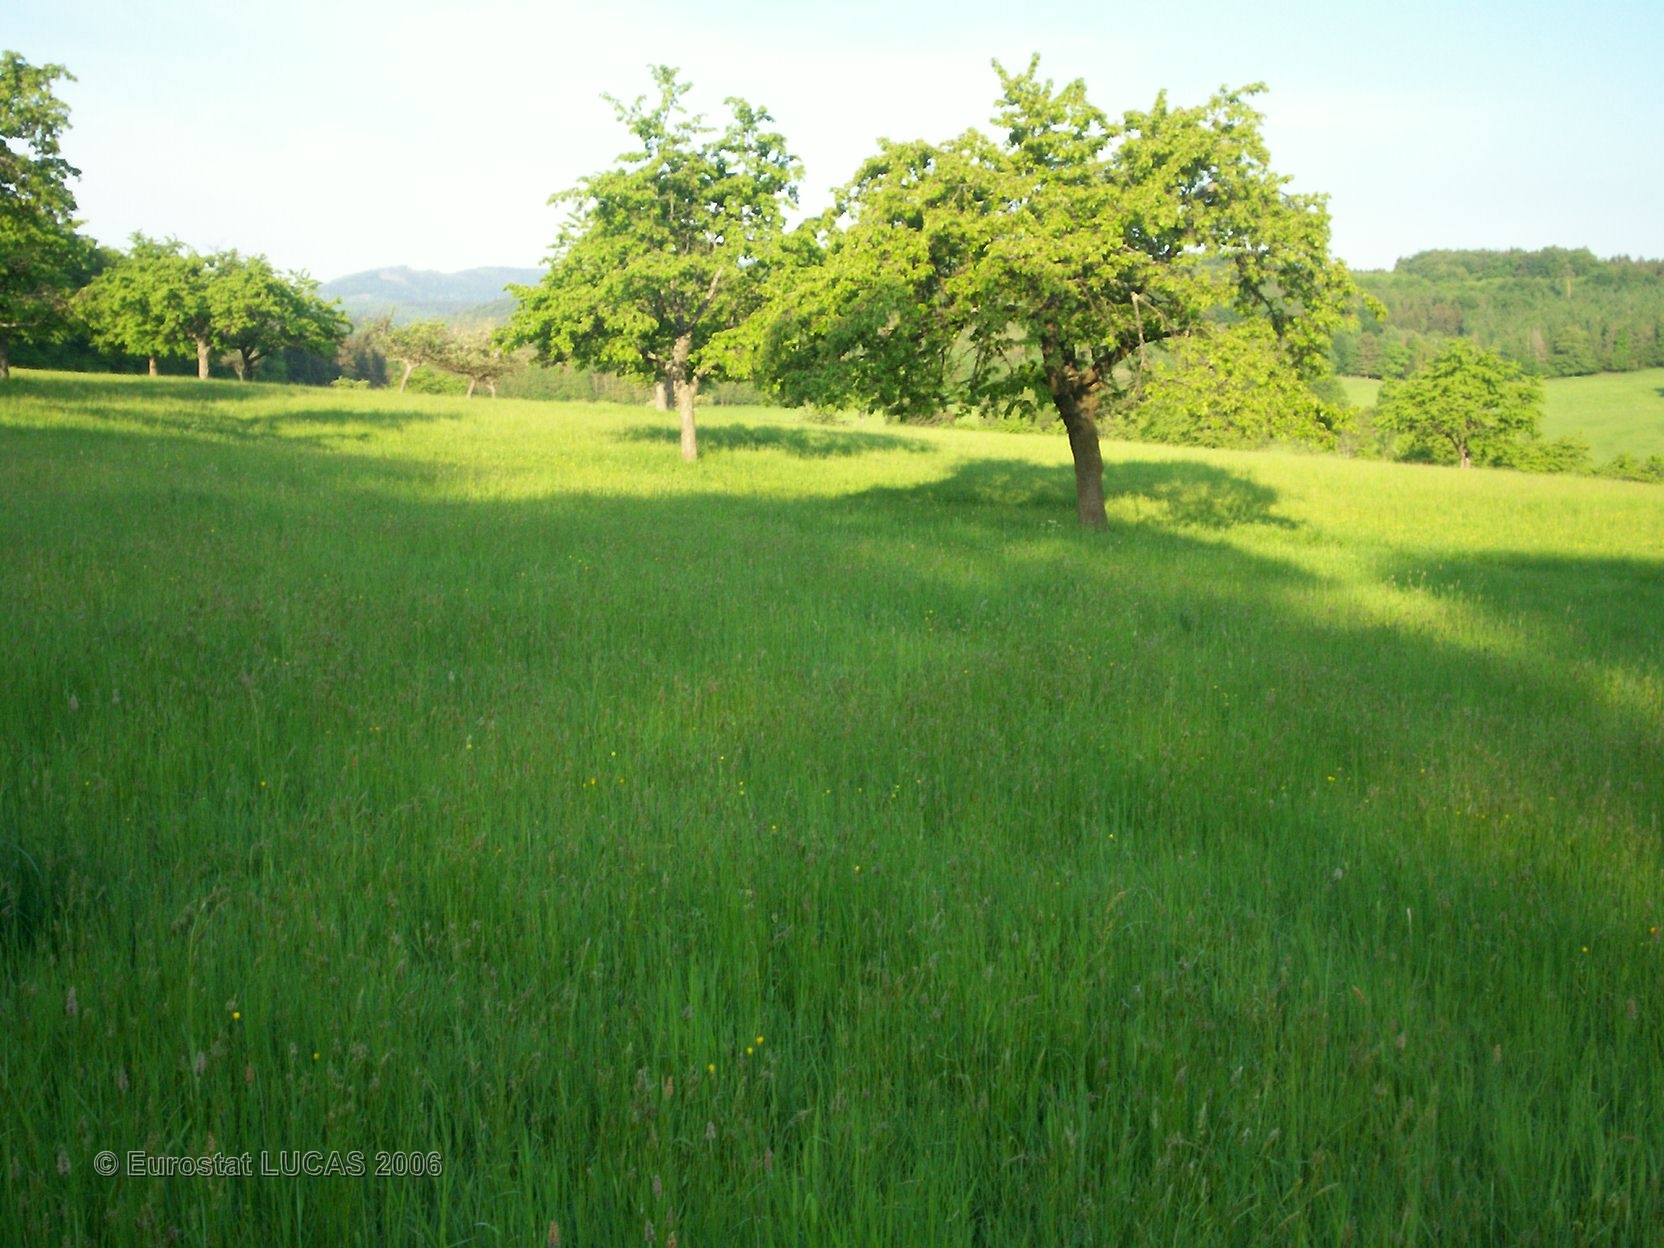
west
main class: Grassland
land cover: Grassland without tree/shrub cover
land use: Agriculture (excluding fallow land and kitchen gardens)
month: May
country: FR
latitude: 48.6245
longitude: 7.3823
